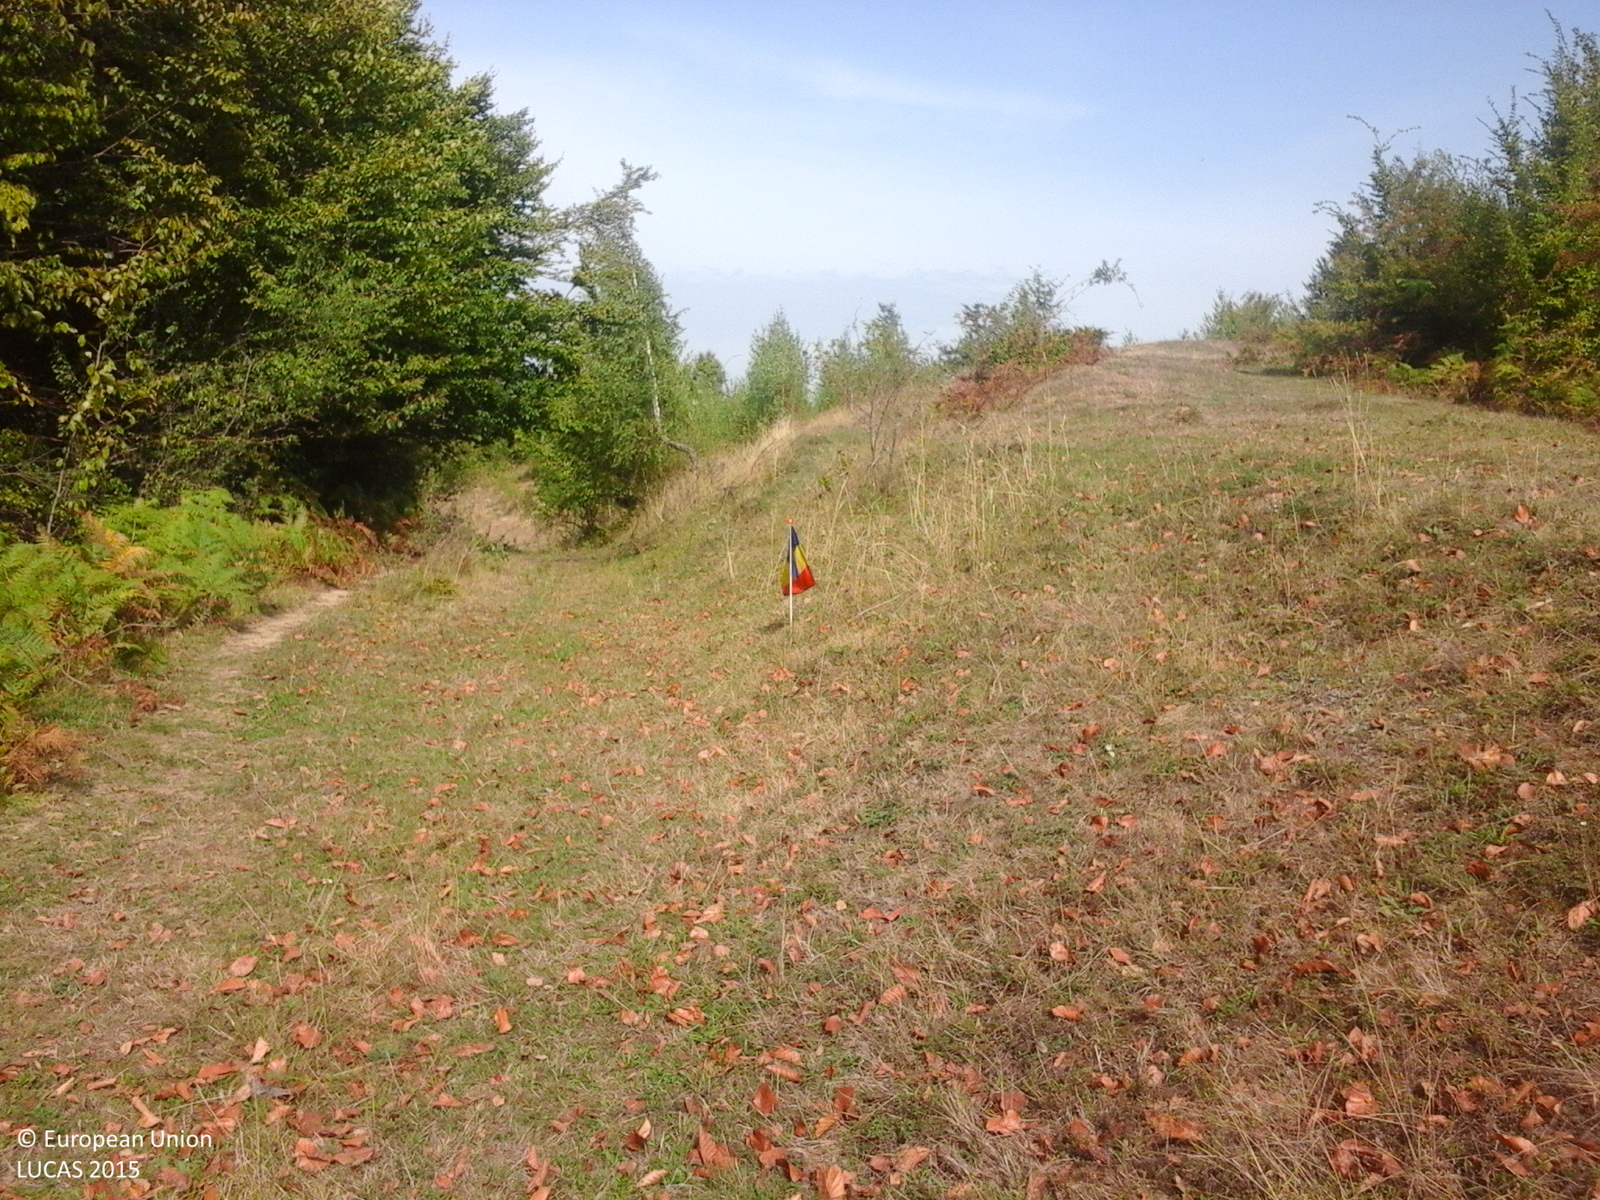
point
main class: Grassland
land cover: Grassland without tree/shrub cover
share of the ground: > 75 %
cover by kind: herbaceous plants 100 %
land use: Agriculture (excluding fallow land and kitchen gardens)
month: September
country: RO
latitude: 47.4353
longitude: 23.9914
